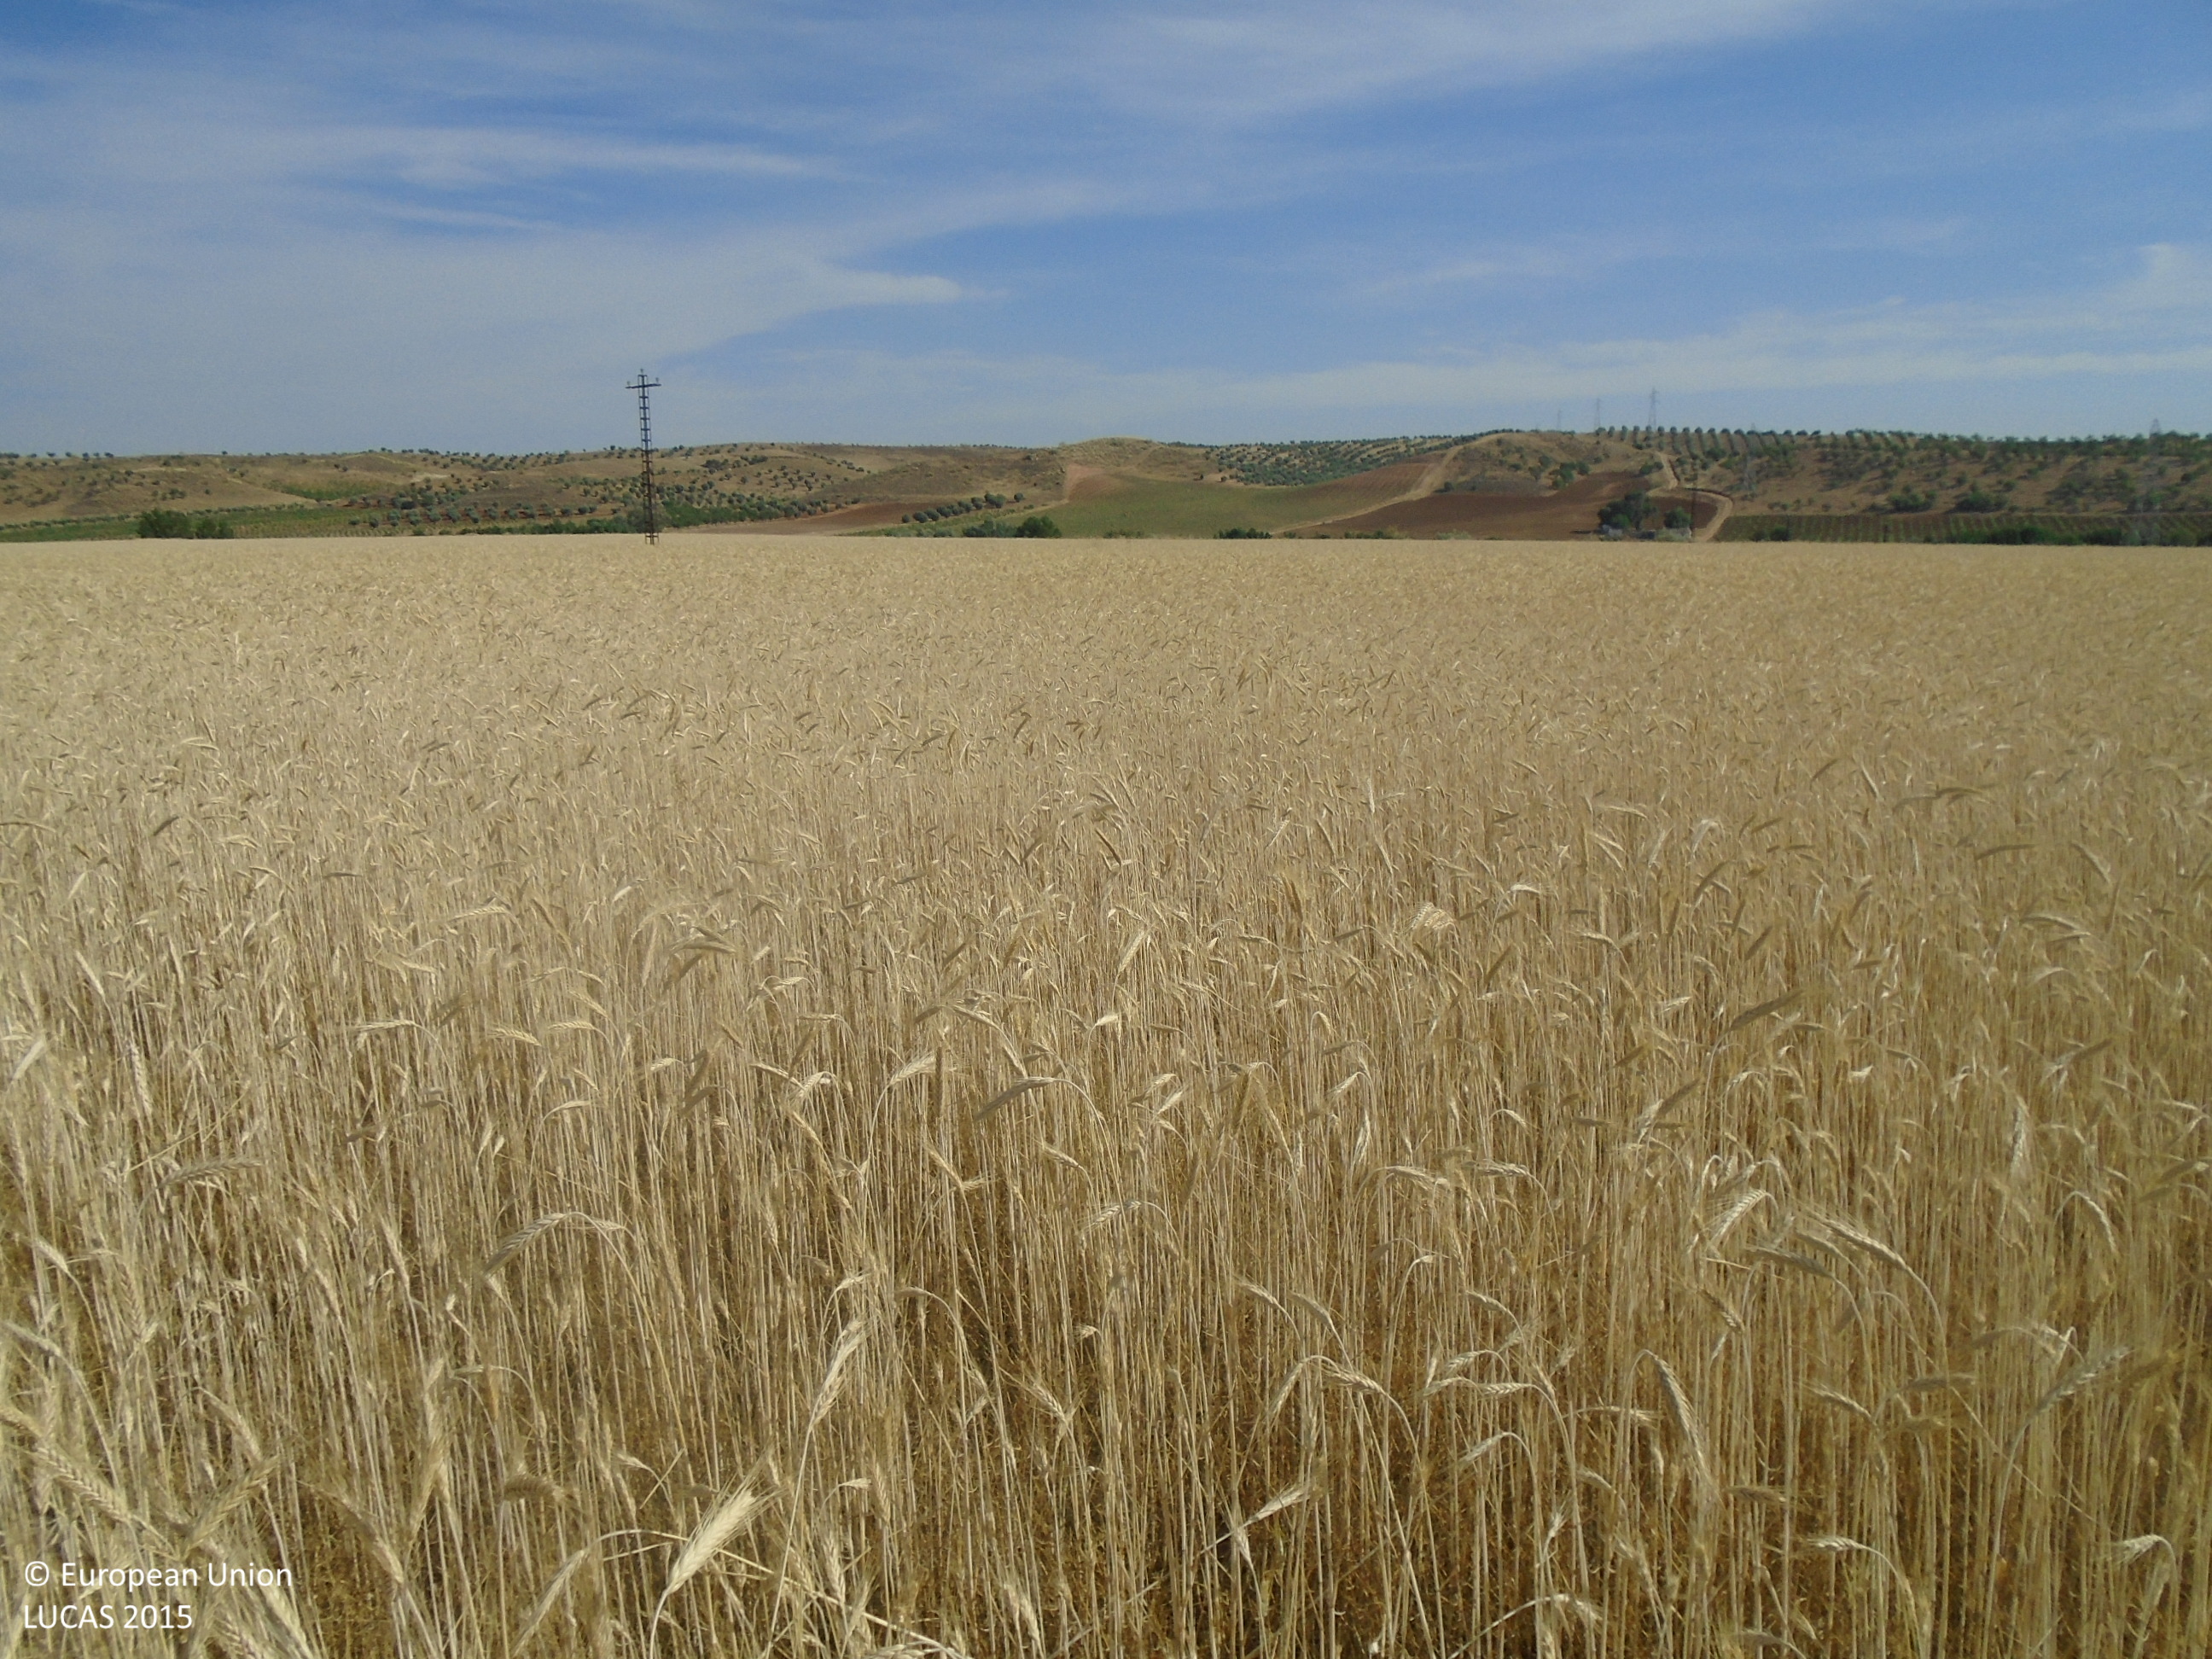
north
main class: Cropland
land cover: Triticale
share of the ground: > 75 %
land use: Agriculture (excluding fallow land and kitchen gardens)
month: June
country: ES
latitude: 39.8389
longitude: -3.7851
